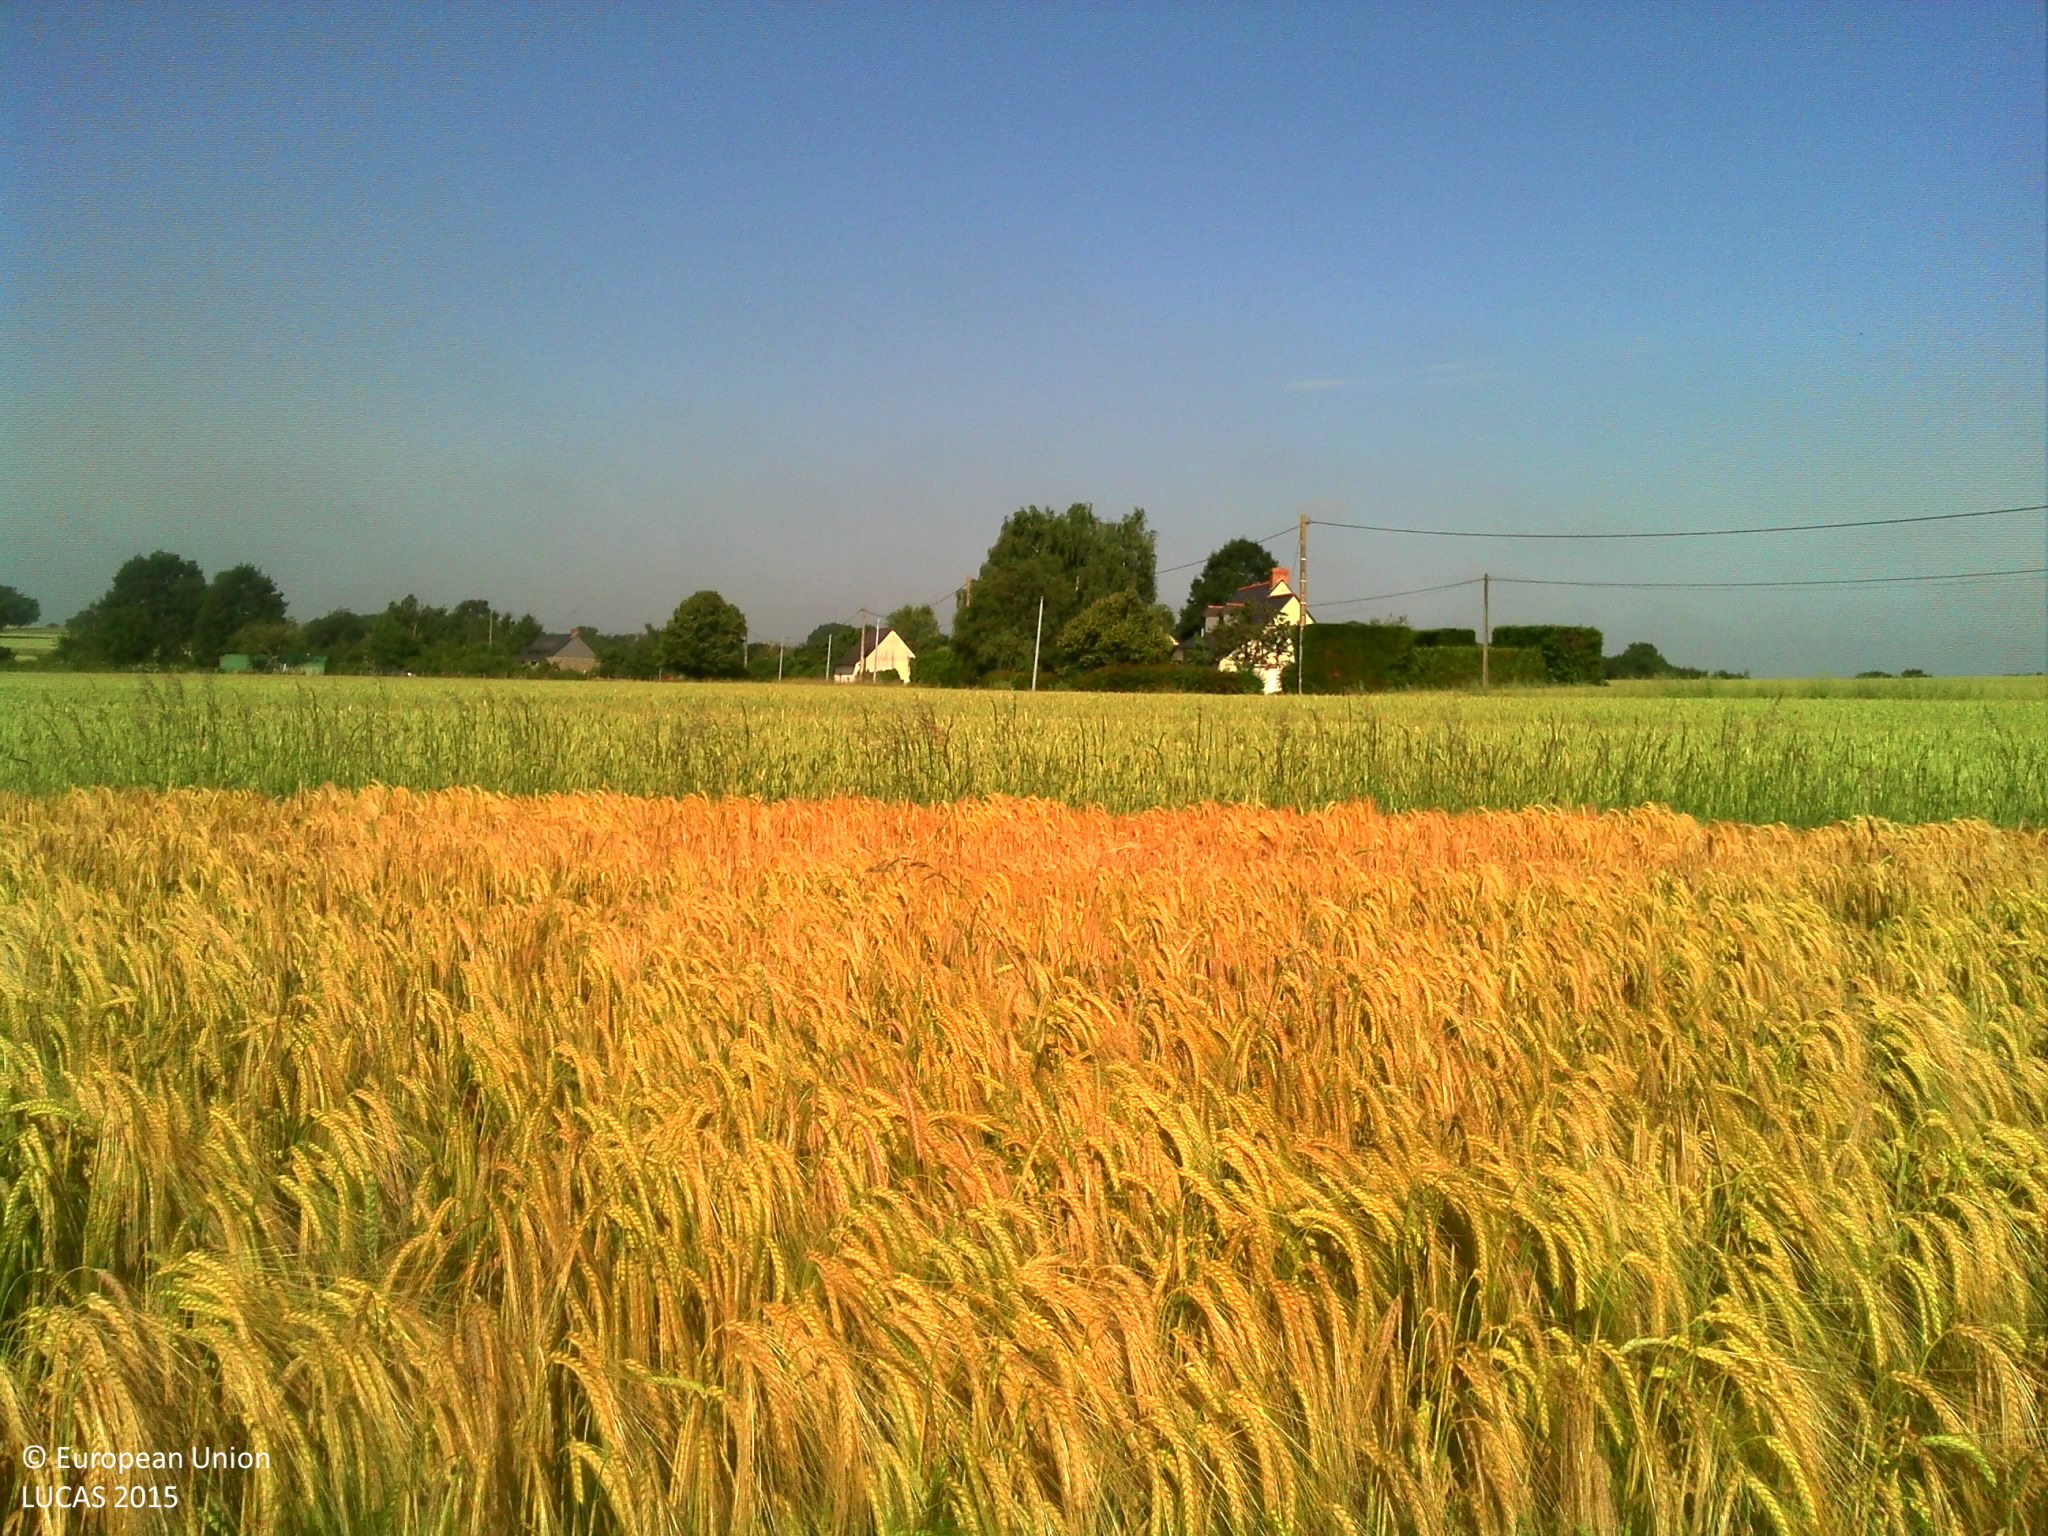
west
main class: Cropland
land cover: Barley
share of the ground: > 75 %
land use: Agriculture (excluding fallow land and kitchen gardens)
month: June
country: FR
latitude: 48.0063
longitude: -1.4515
